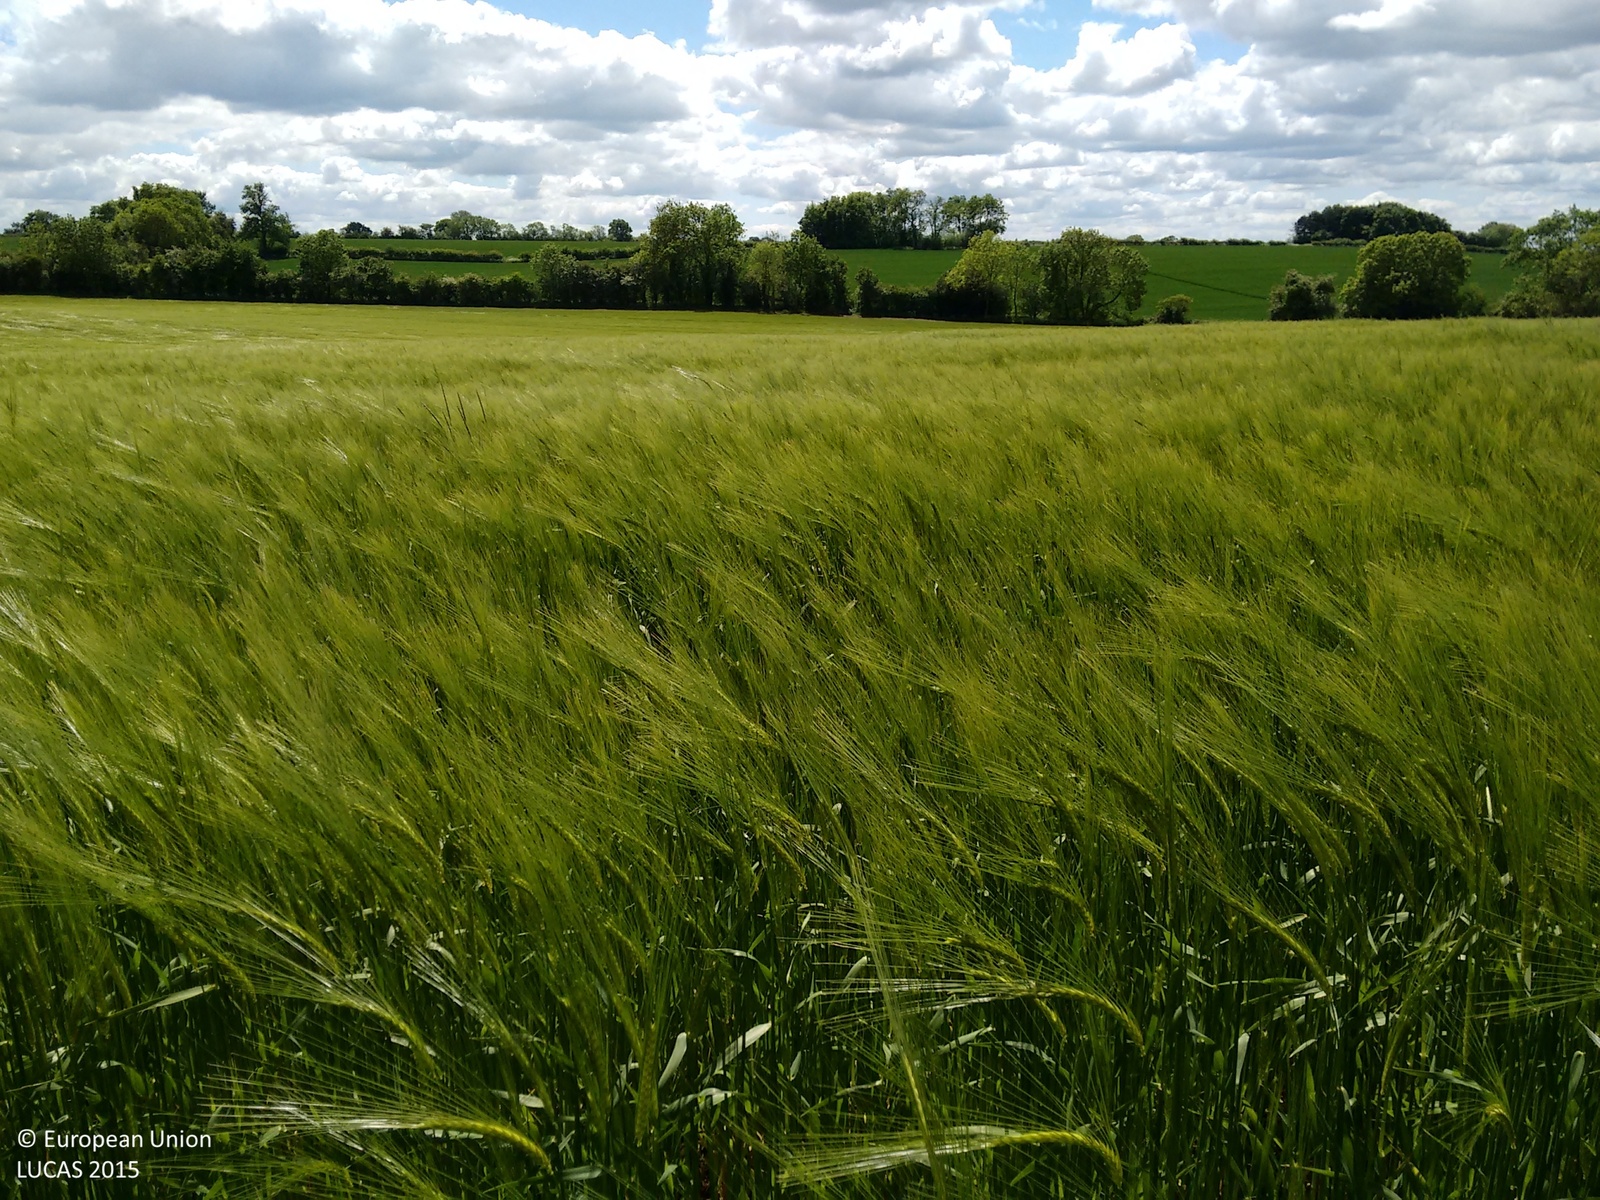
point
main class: Cropland
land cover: Barley
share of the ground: > 75 %
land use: Agriculture (excluding fallow land and kitchen gardens)
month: June
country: GB
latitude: 52.4473
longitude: -1.3635
